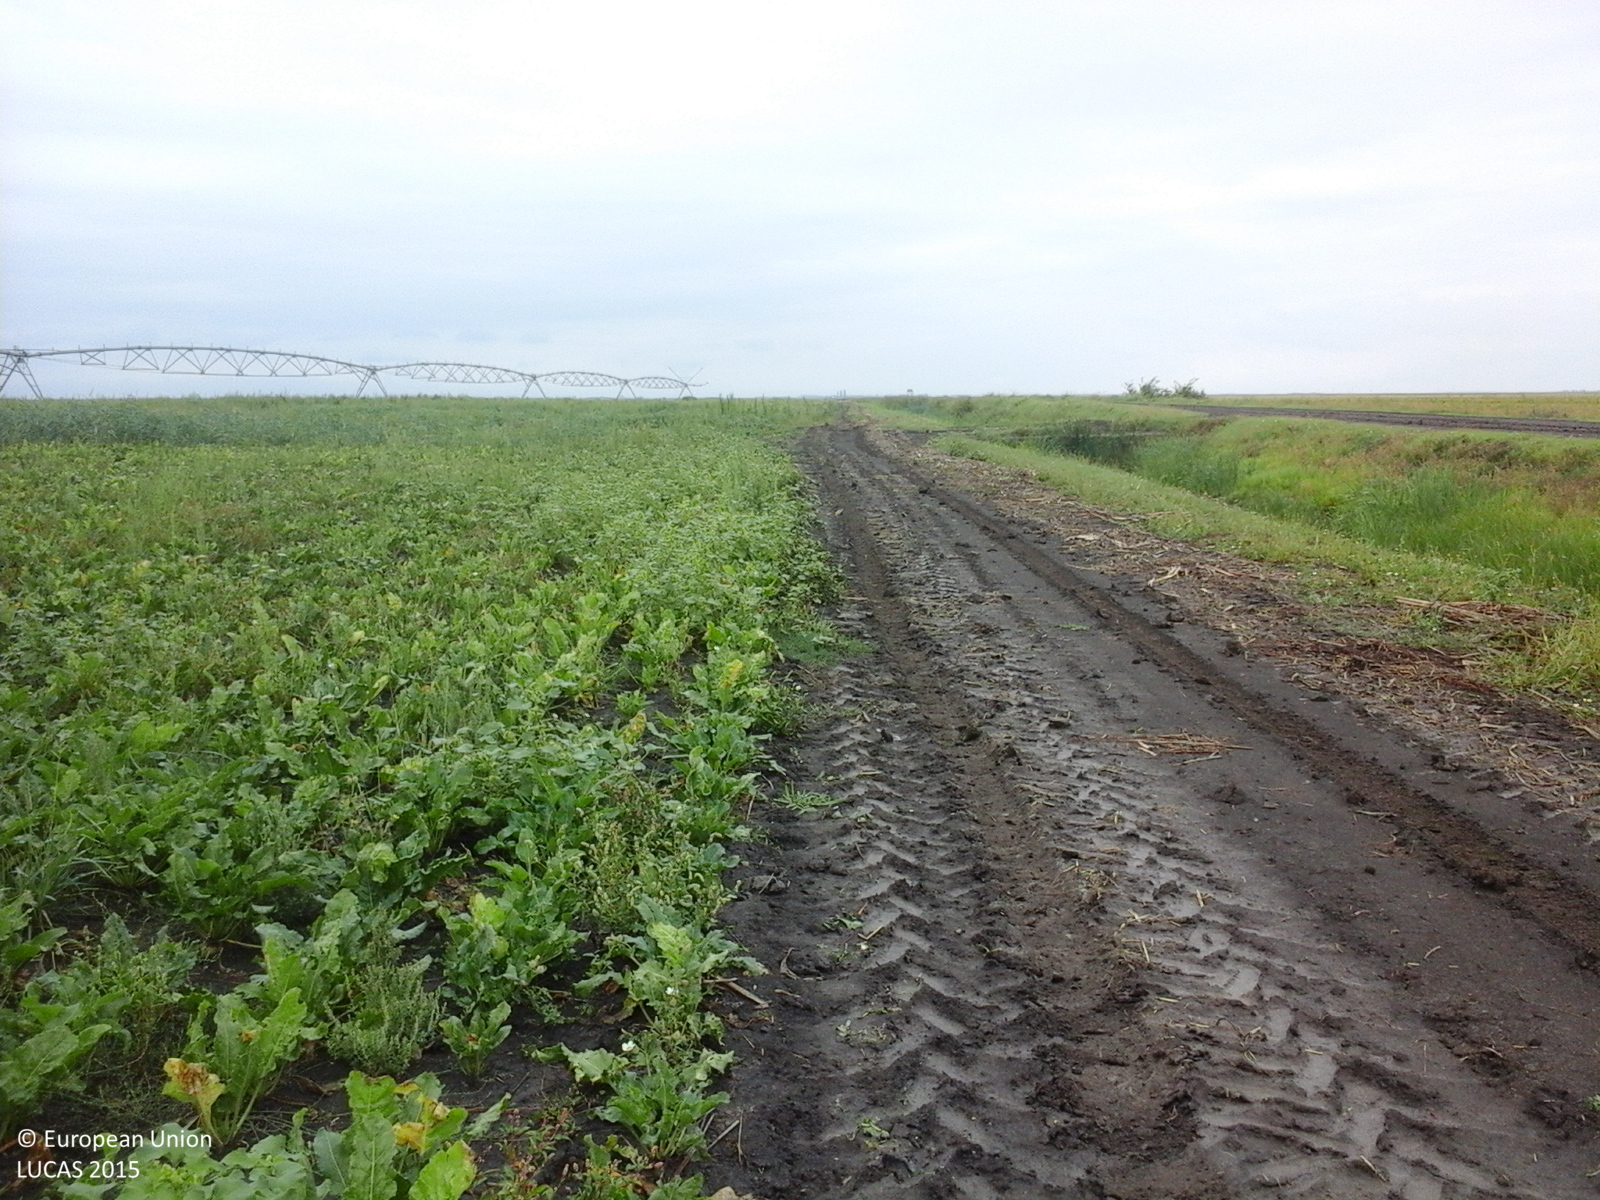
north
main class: Cropland
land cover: Sugar beet
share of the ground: > 75 %
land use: Agriculture (excluding fallow land and kitchen gardens)
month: August
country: RO
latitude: 46.0629
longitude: 20.3778
